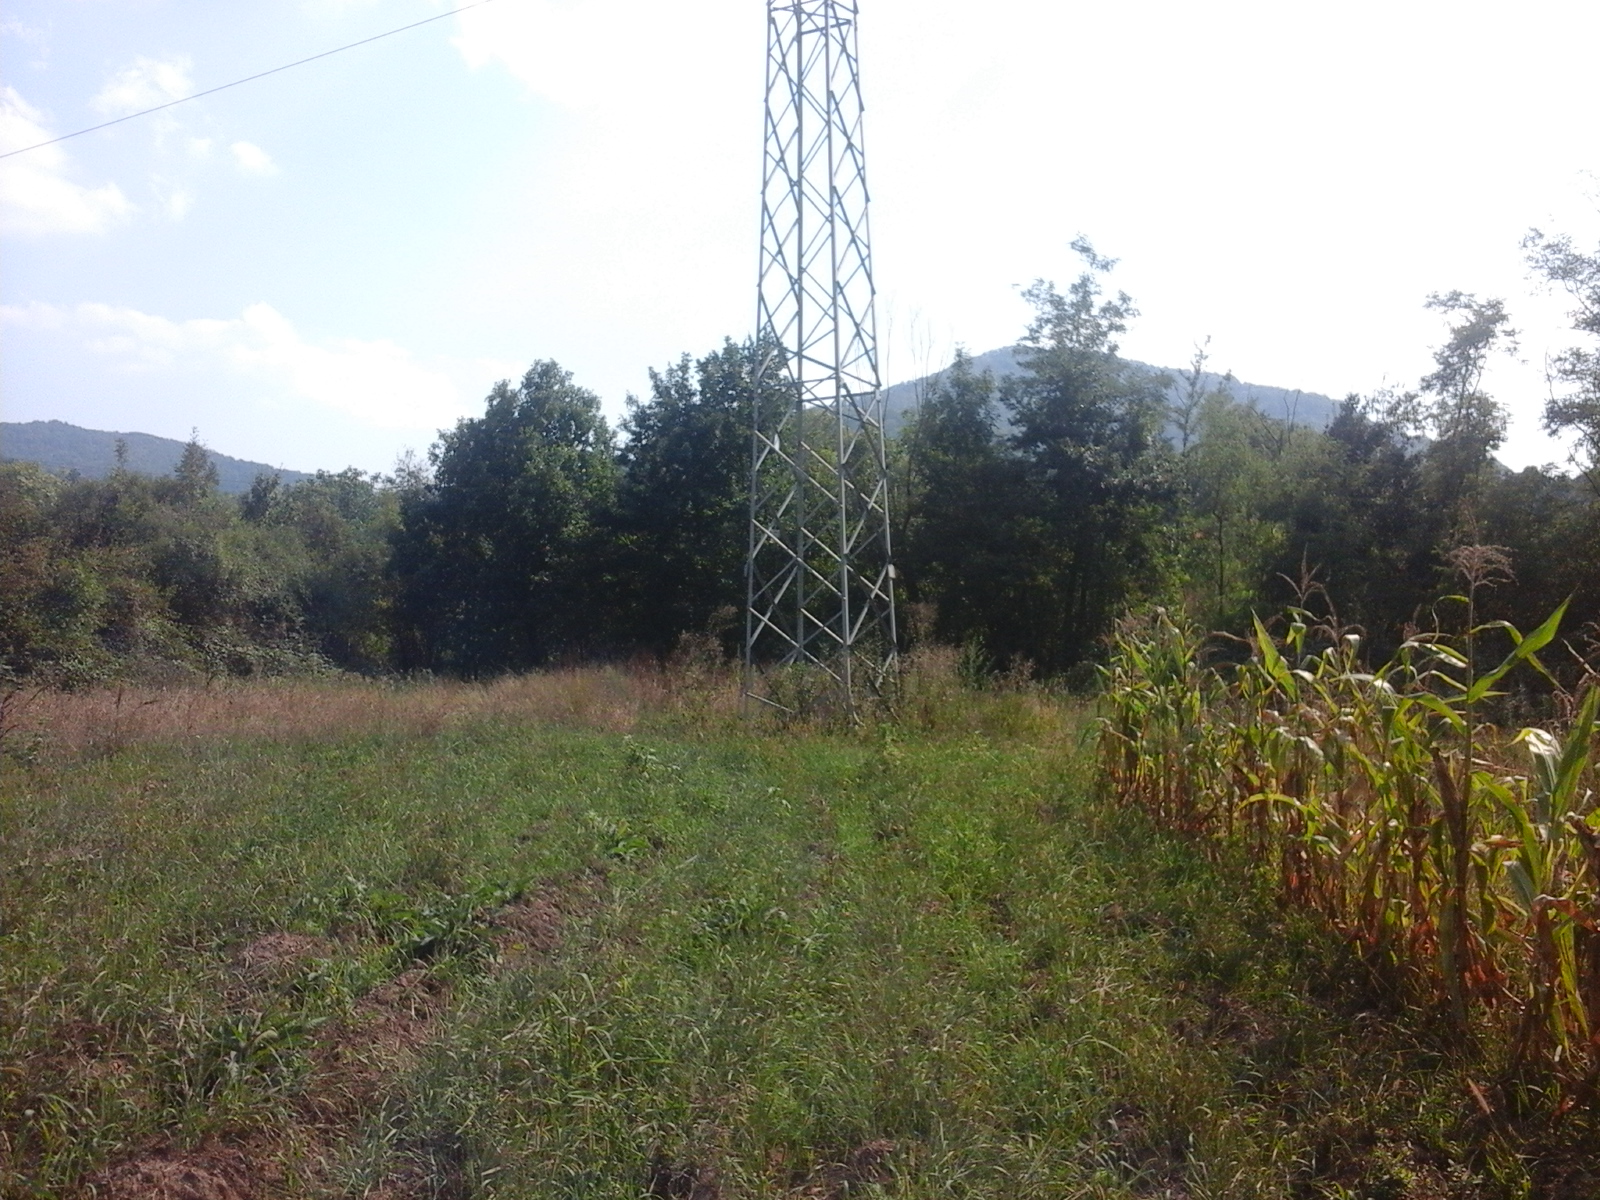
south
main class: Cropland
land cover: Potatoes
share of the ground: > 75 %
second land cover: Spontaneously vegetated surfaces
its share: > 75 %
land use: Agriculture (excluding fallow land and kitchen gardens)
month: August
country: RO
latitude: 46.2832
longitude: 22.3914
